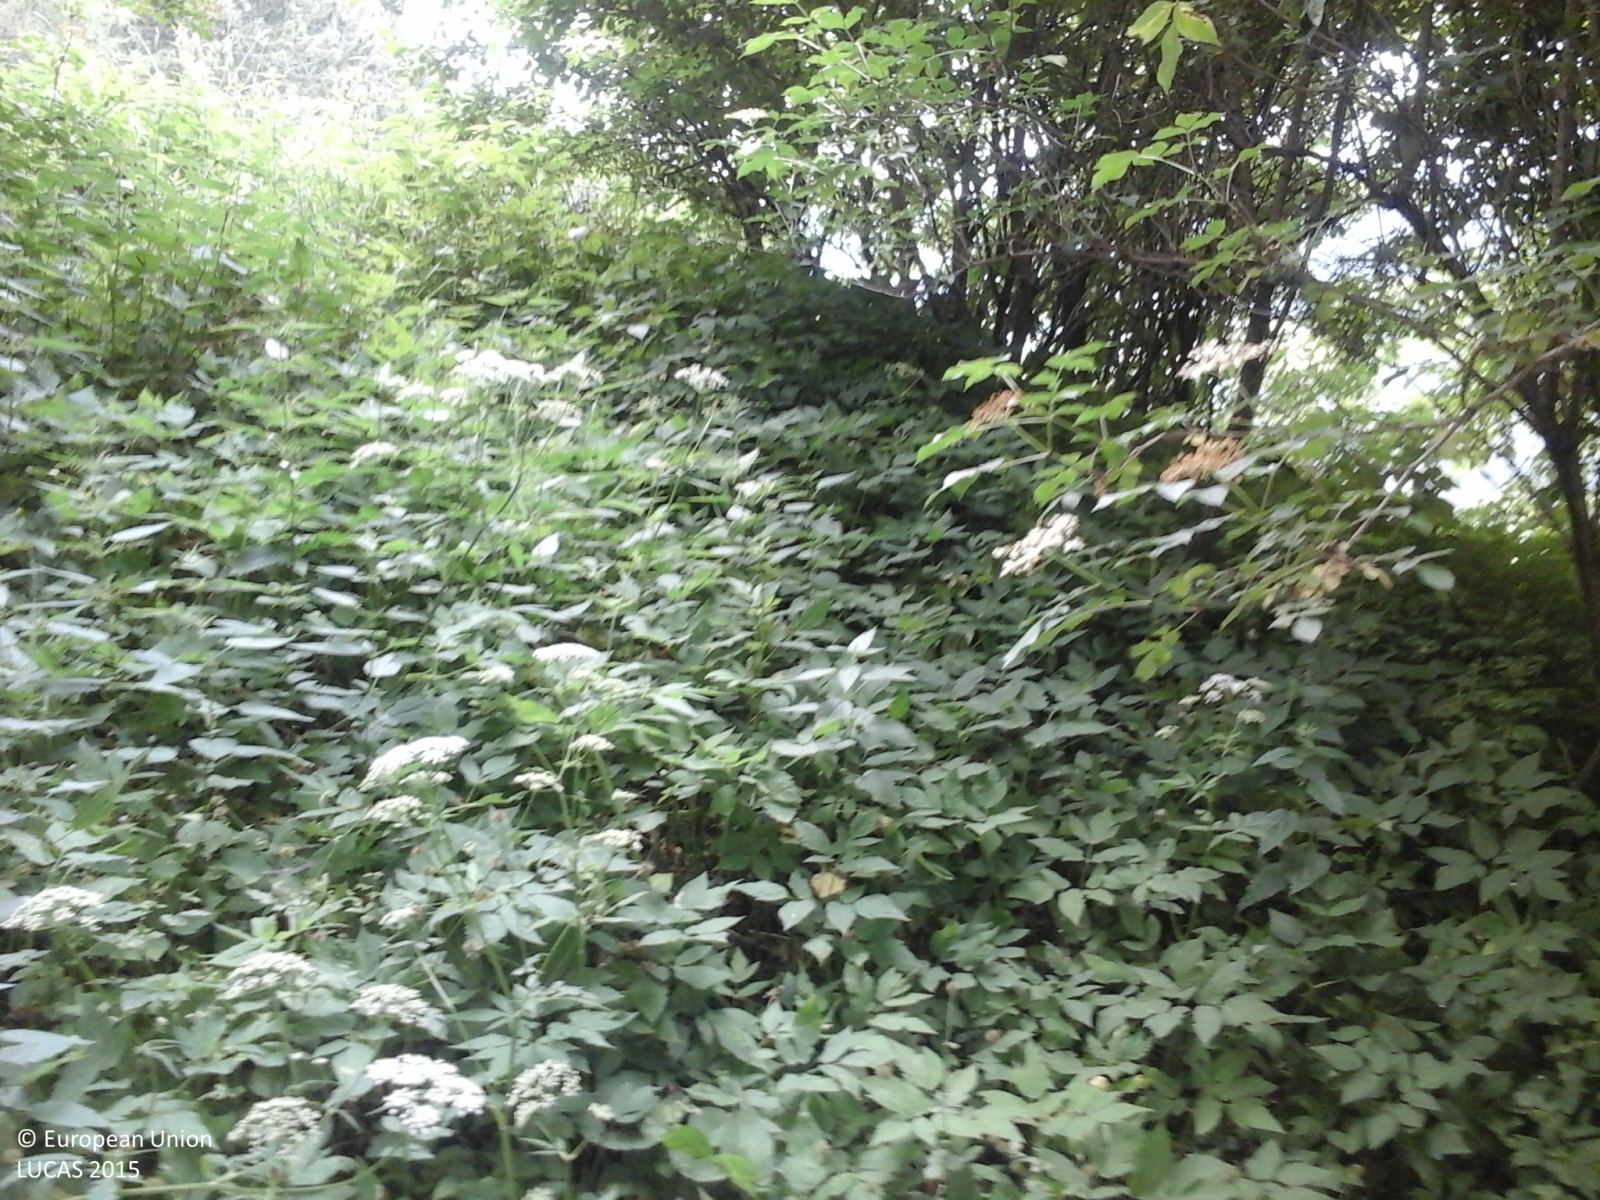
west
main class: Woodland
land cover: Spruce dominated coniferous woodland
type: alpine coniferous forest
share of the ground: > 75 %
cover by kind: coniferous forest trees 100 %
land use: Forestry
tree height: > 5 m
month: July
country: IT
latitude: 46.7464
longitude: 12.0267
